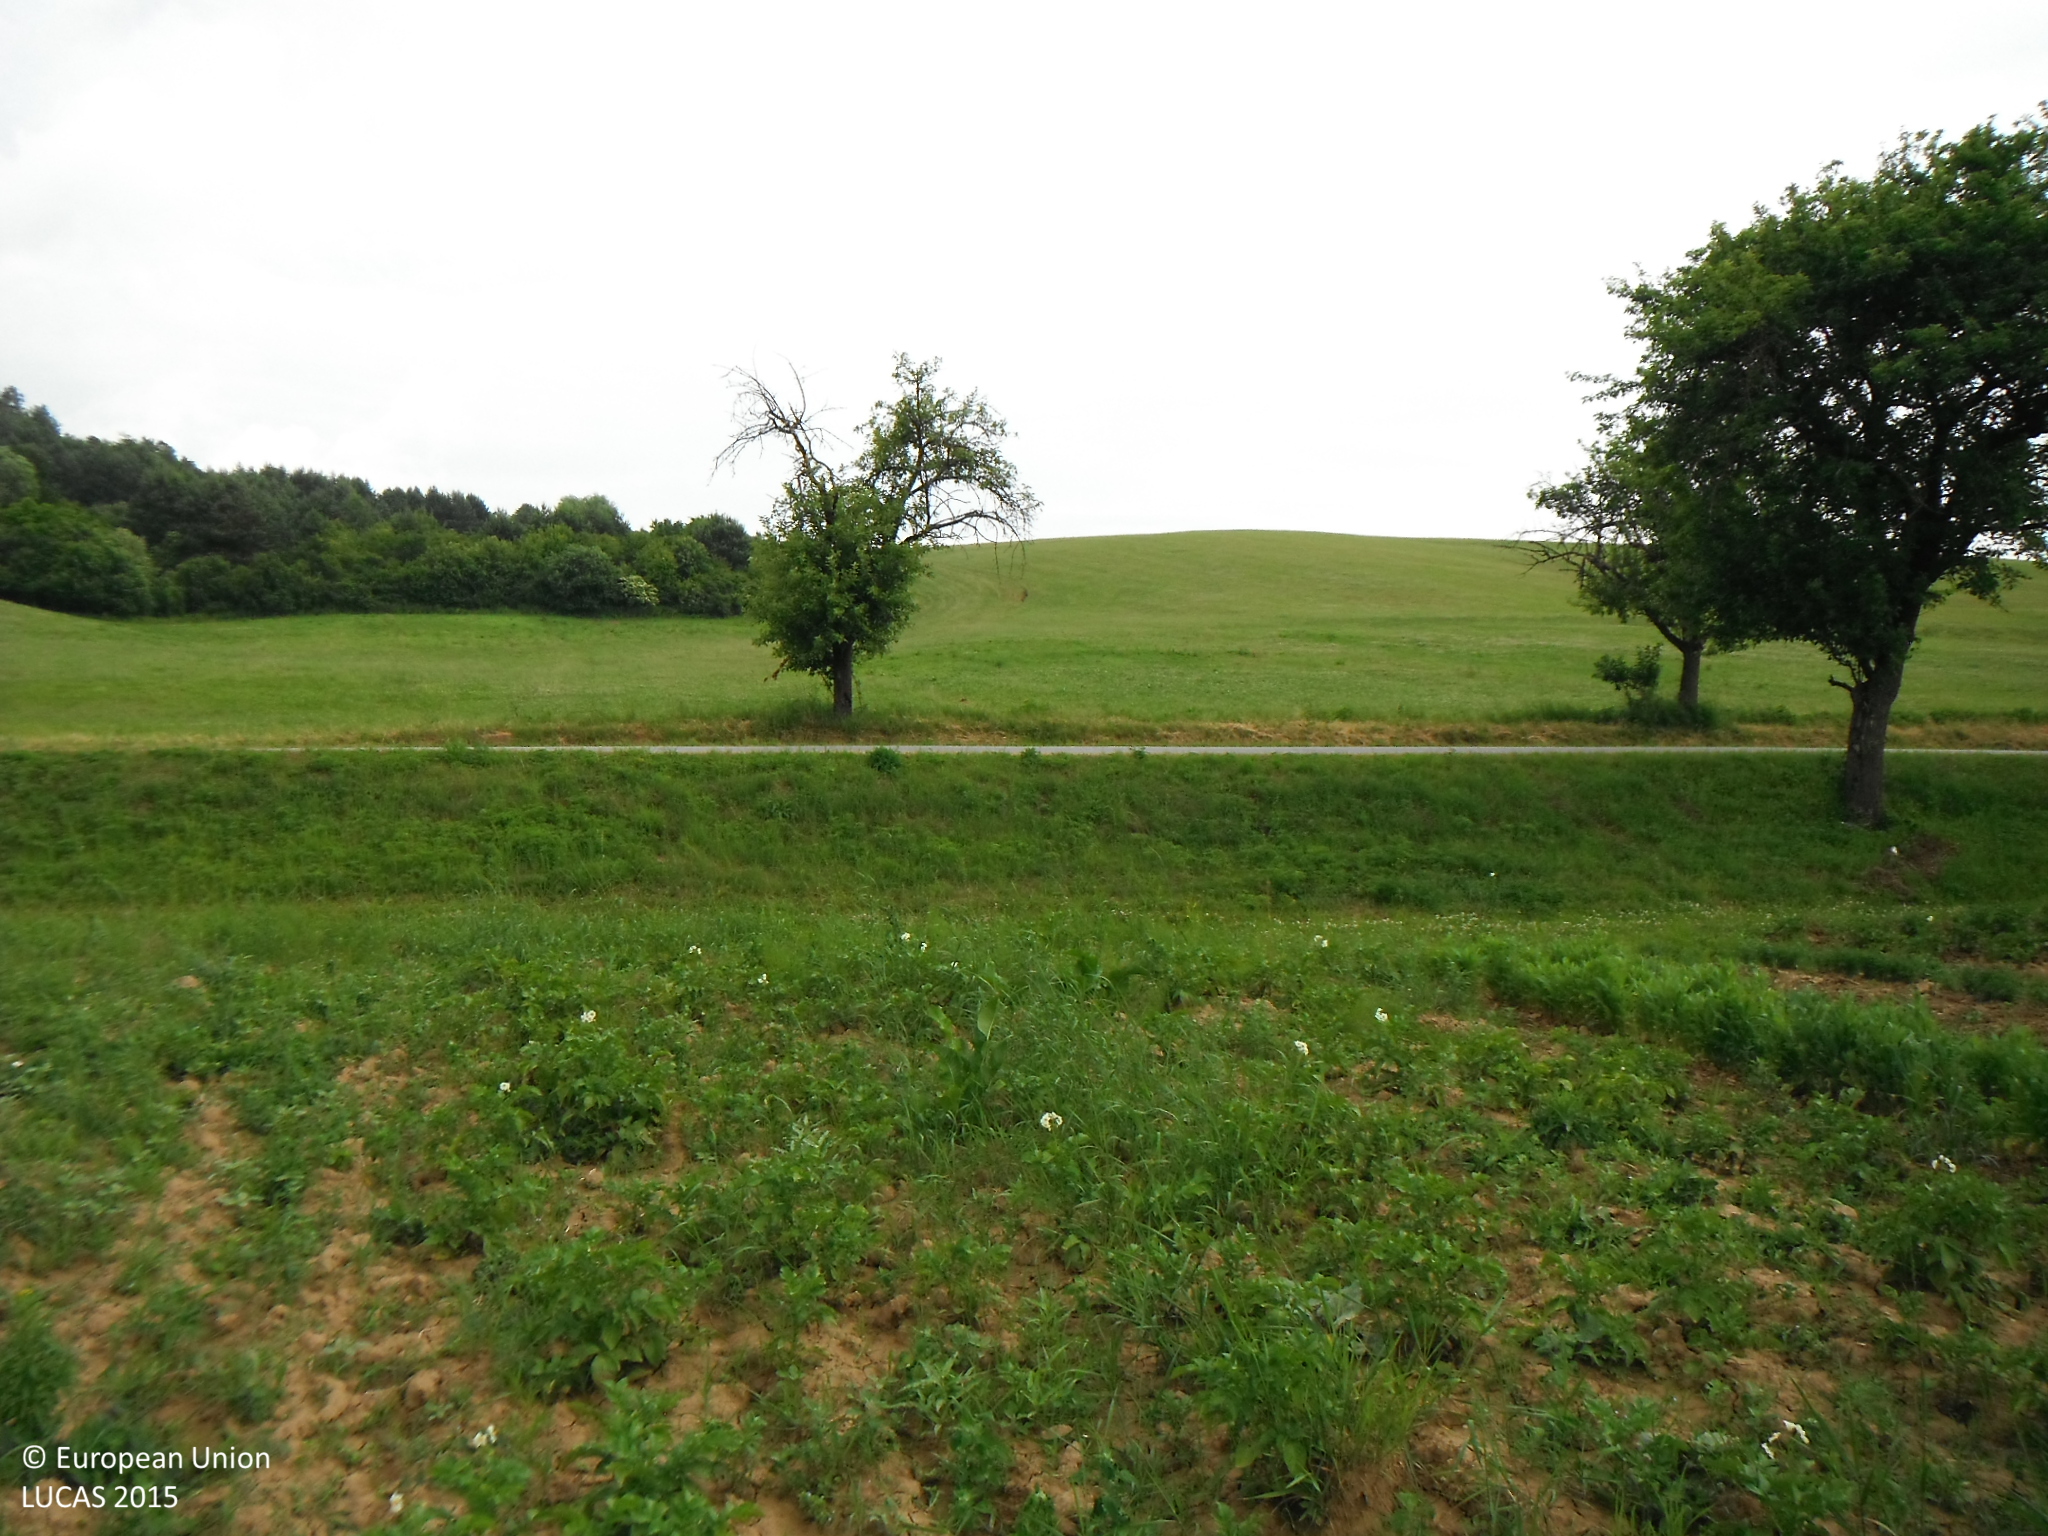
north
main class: Cropland
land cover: Potatoes
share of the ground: 25 - 50 %
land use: Kitchen garden
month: June
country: SK
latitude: 49.1398
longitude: 21.3831
